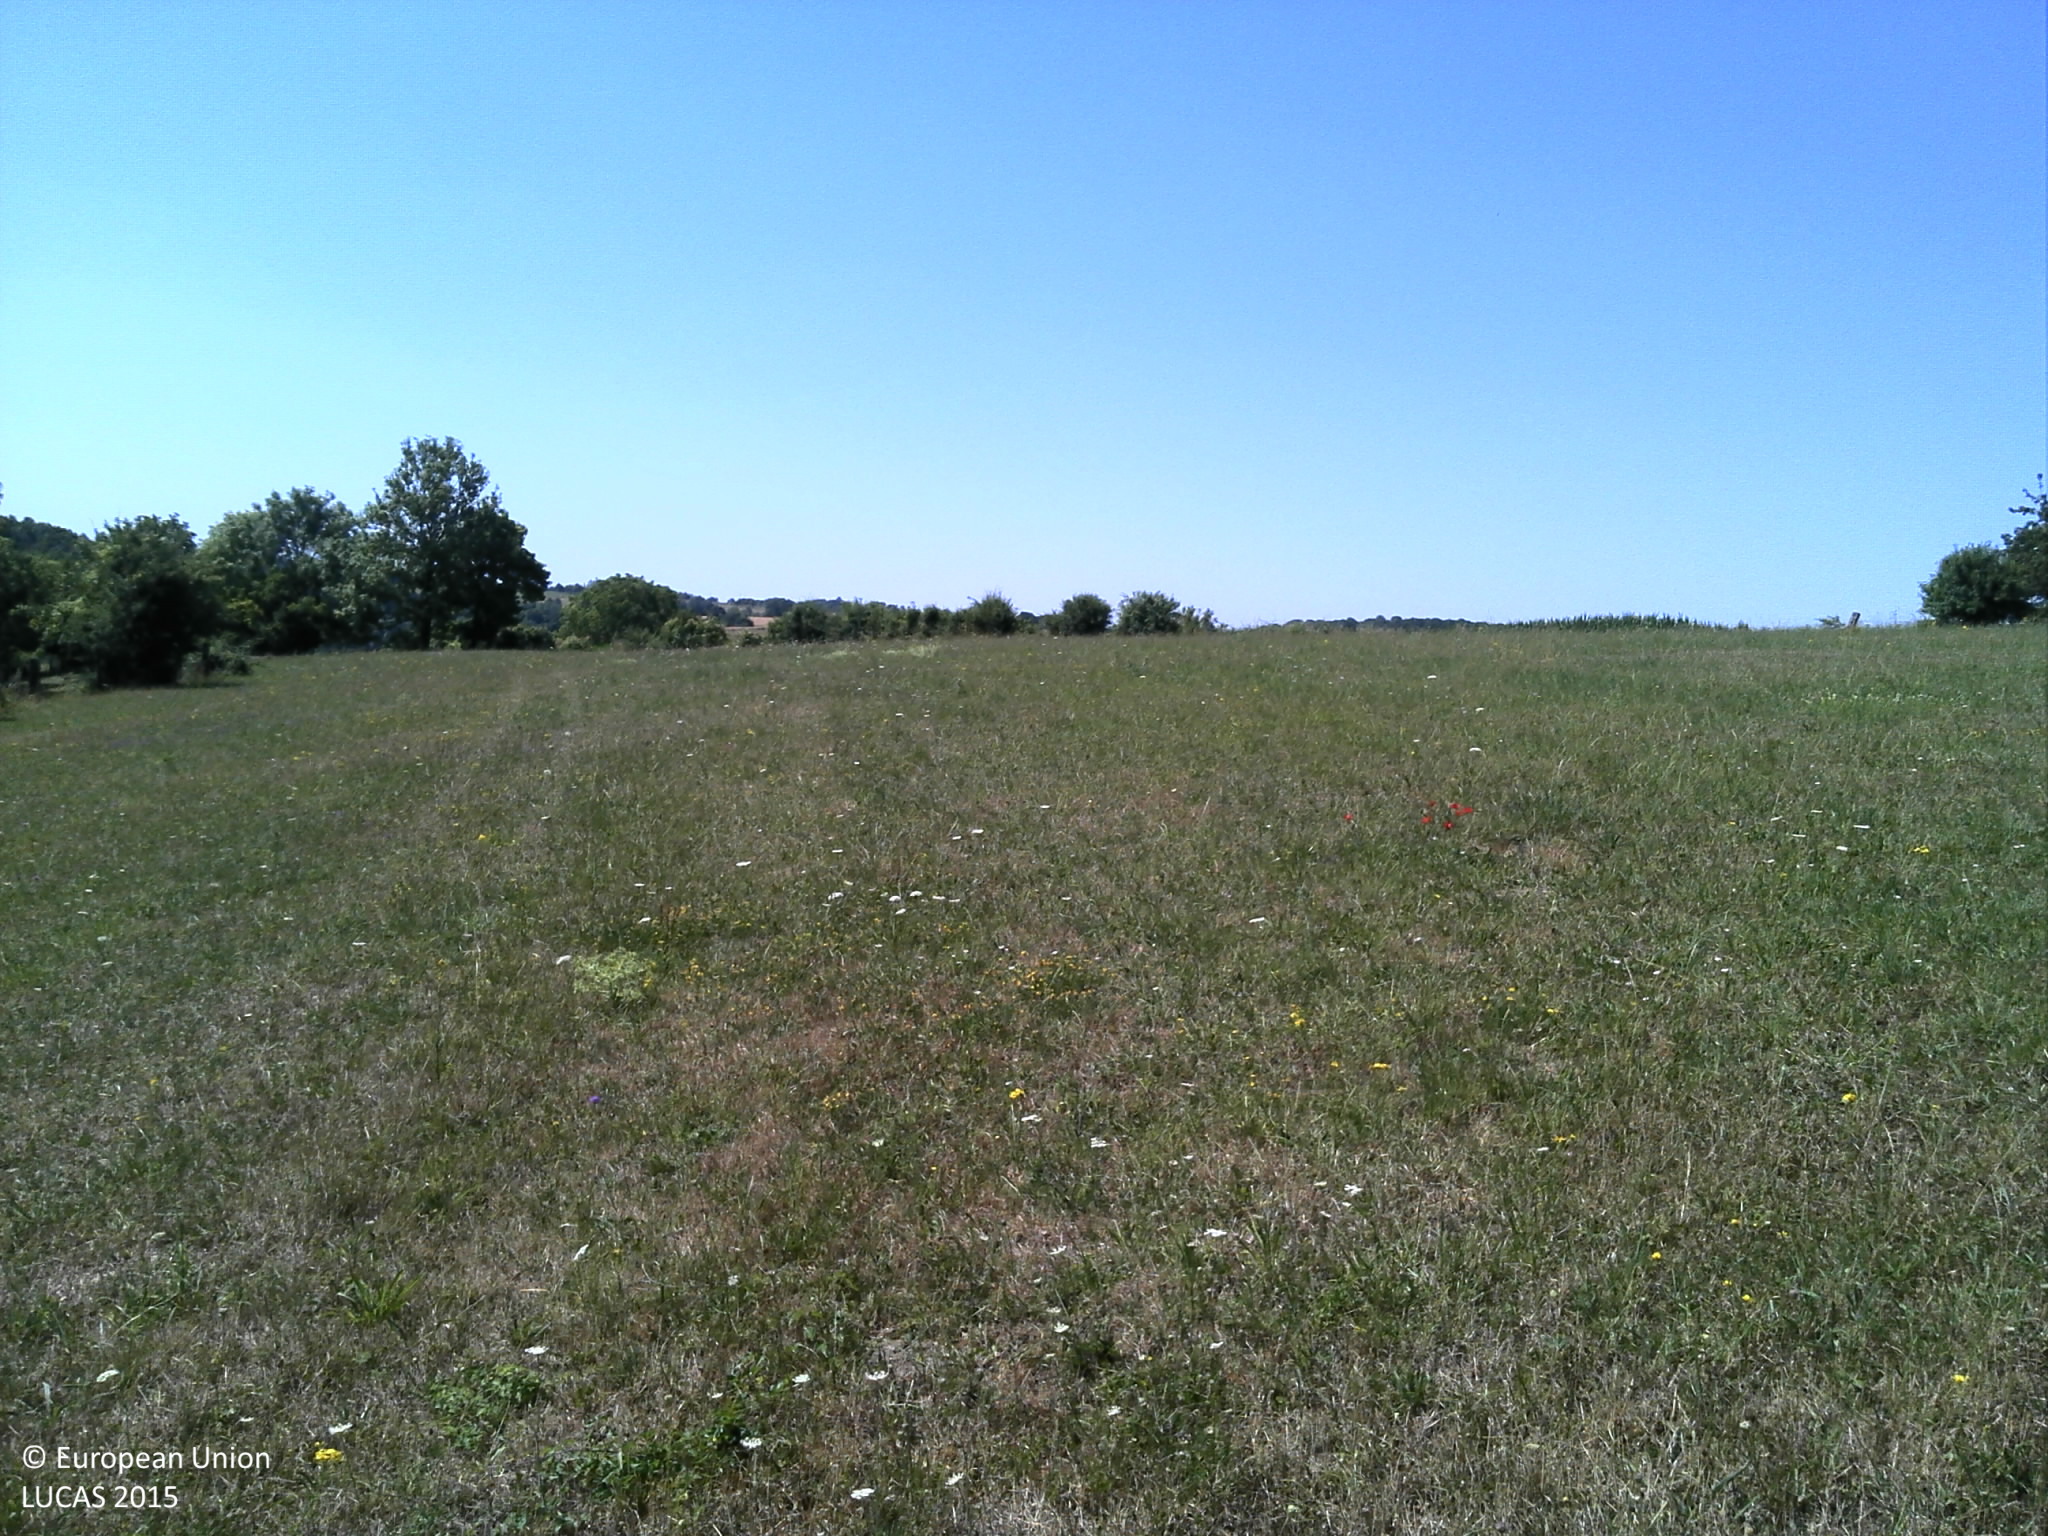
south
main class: Grassland
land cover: Grassland without tree/shrub cover
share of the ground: > 75 %
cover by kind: herbaceous plants 100 %
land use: Agriculture (excluding fallow land and kitchen gardens)
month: July
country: FR
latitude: 49.5884
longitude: 4.6155
